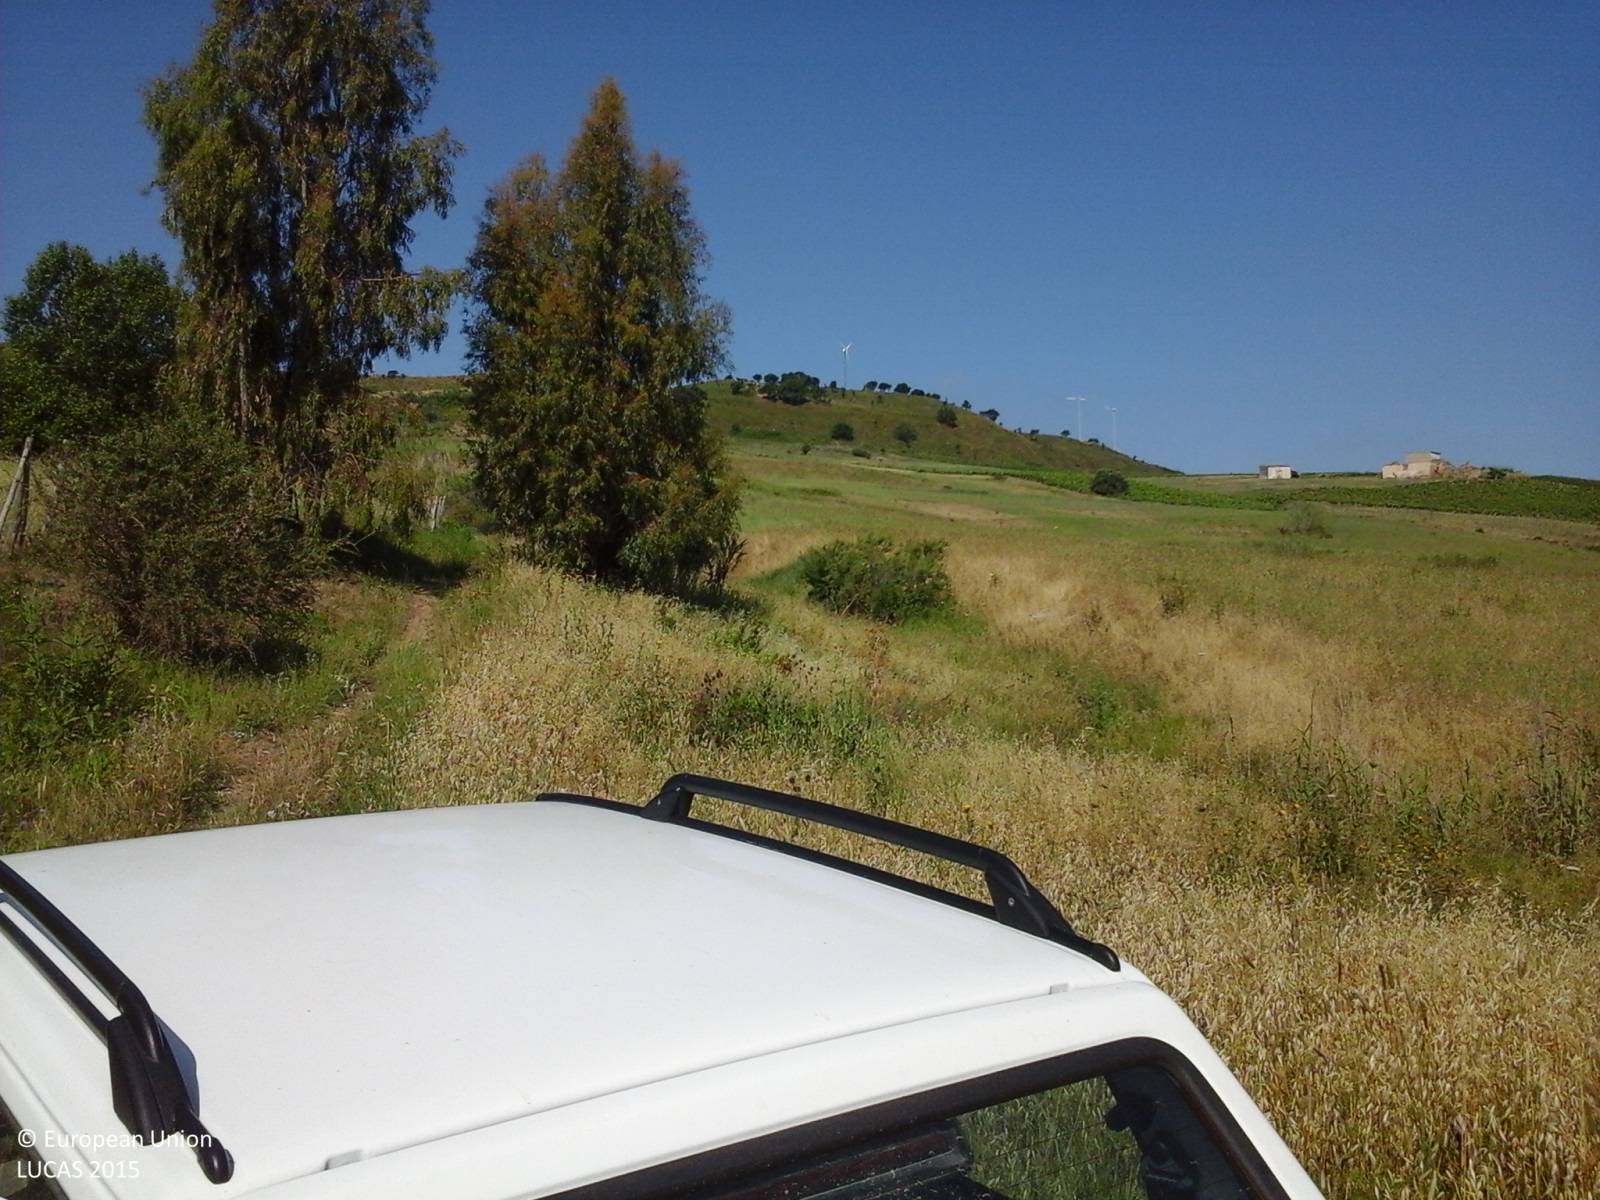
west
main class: Grassland
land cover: Grassland without tree/shrub cover
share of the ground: > 75 %
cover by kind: herbaceous plants 100 %
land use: Semi-natural and natural areas not in use
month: June
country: IT
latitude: 37.9699
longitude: 13.0854
